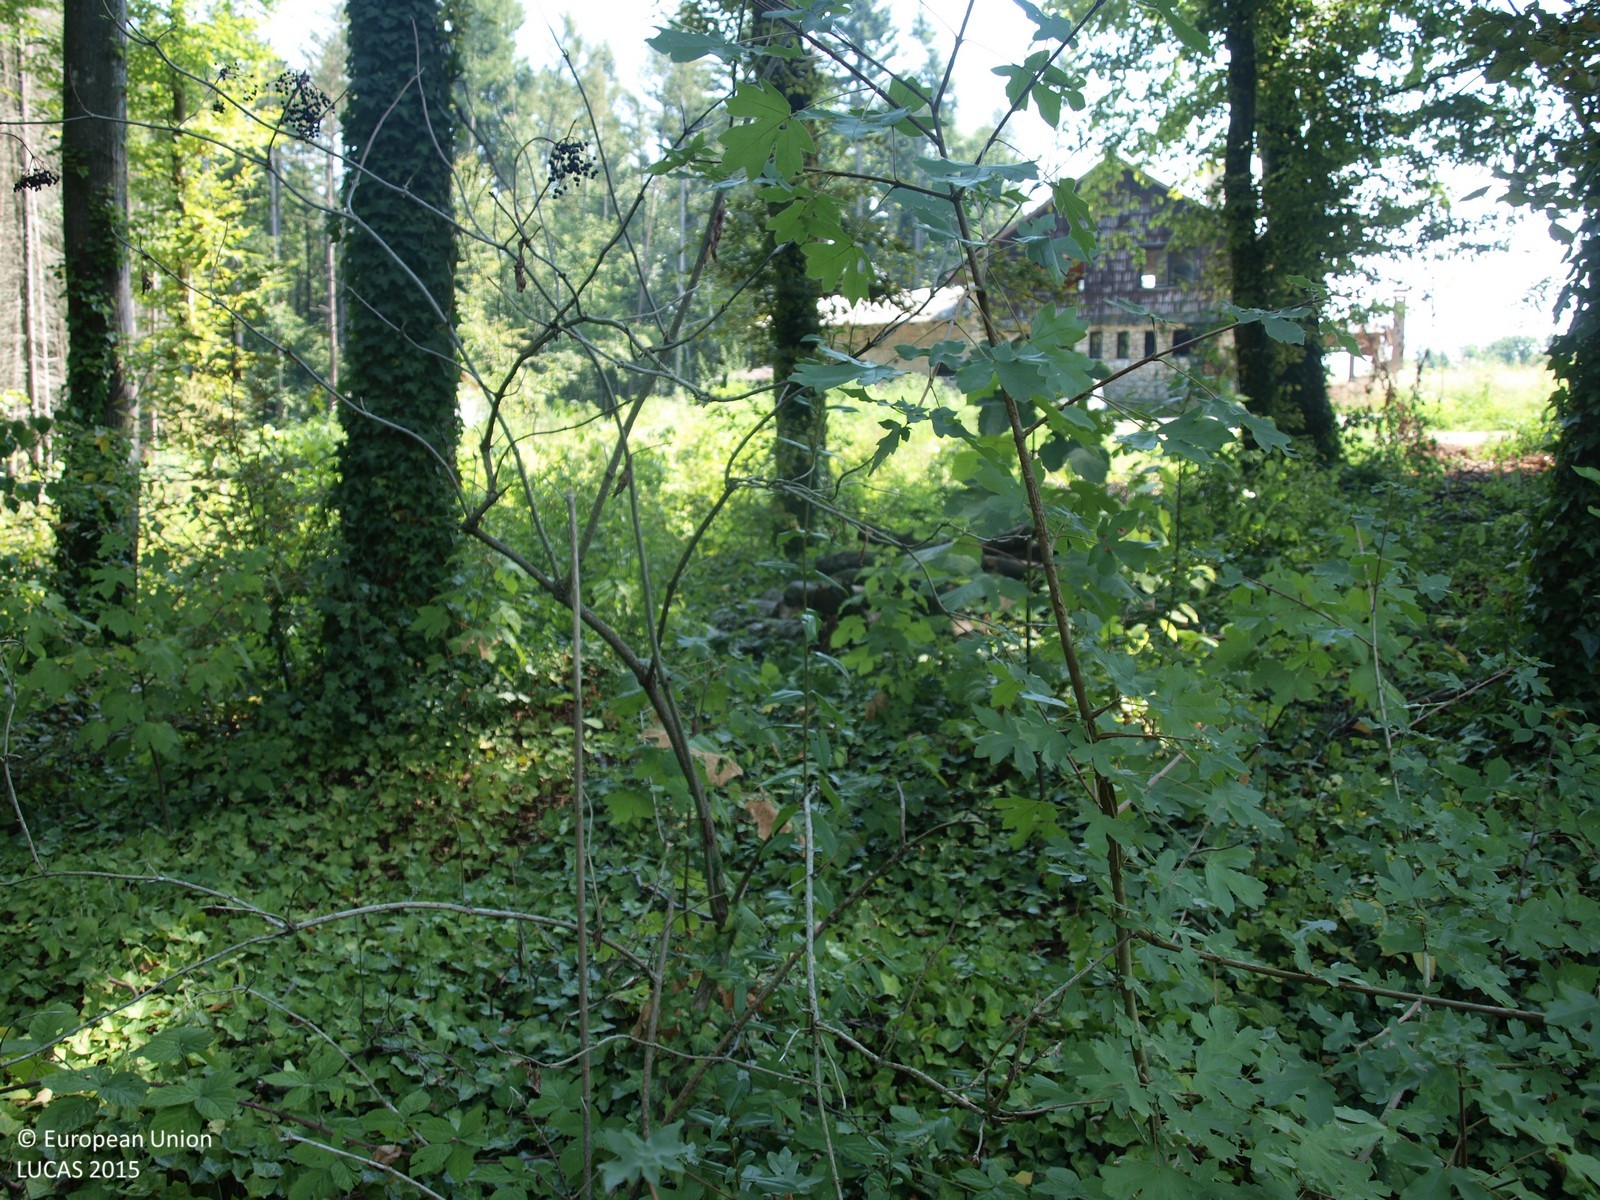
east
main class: Woodland
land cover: Broadleaved woodland
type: mesophytic deciduous forest
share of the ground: > 75 %
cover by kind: broadleaved forest trees 100 %
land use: Forestry
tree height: > 5 m
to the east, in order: Broadleaved woodland; Artificial constructions in urban areas; Broadleaved woodland; Electric lines; Broadleaved woodland; Maize
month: August
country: HR
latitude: 46.0255
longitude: 16.5236
